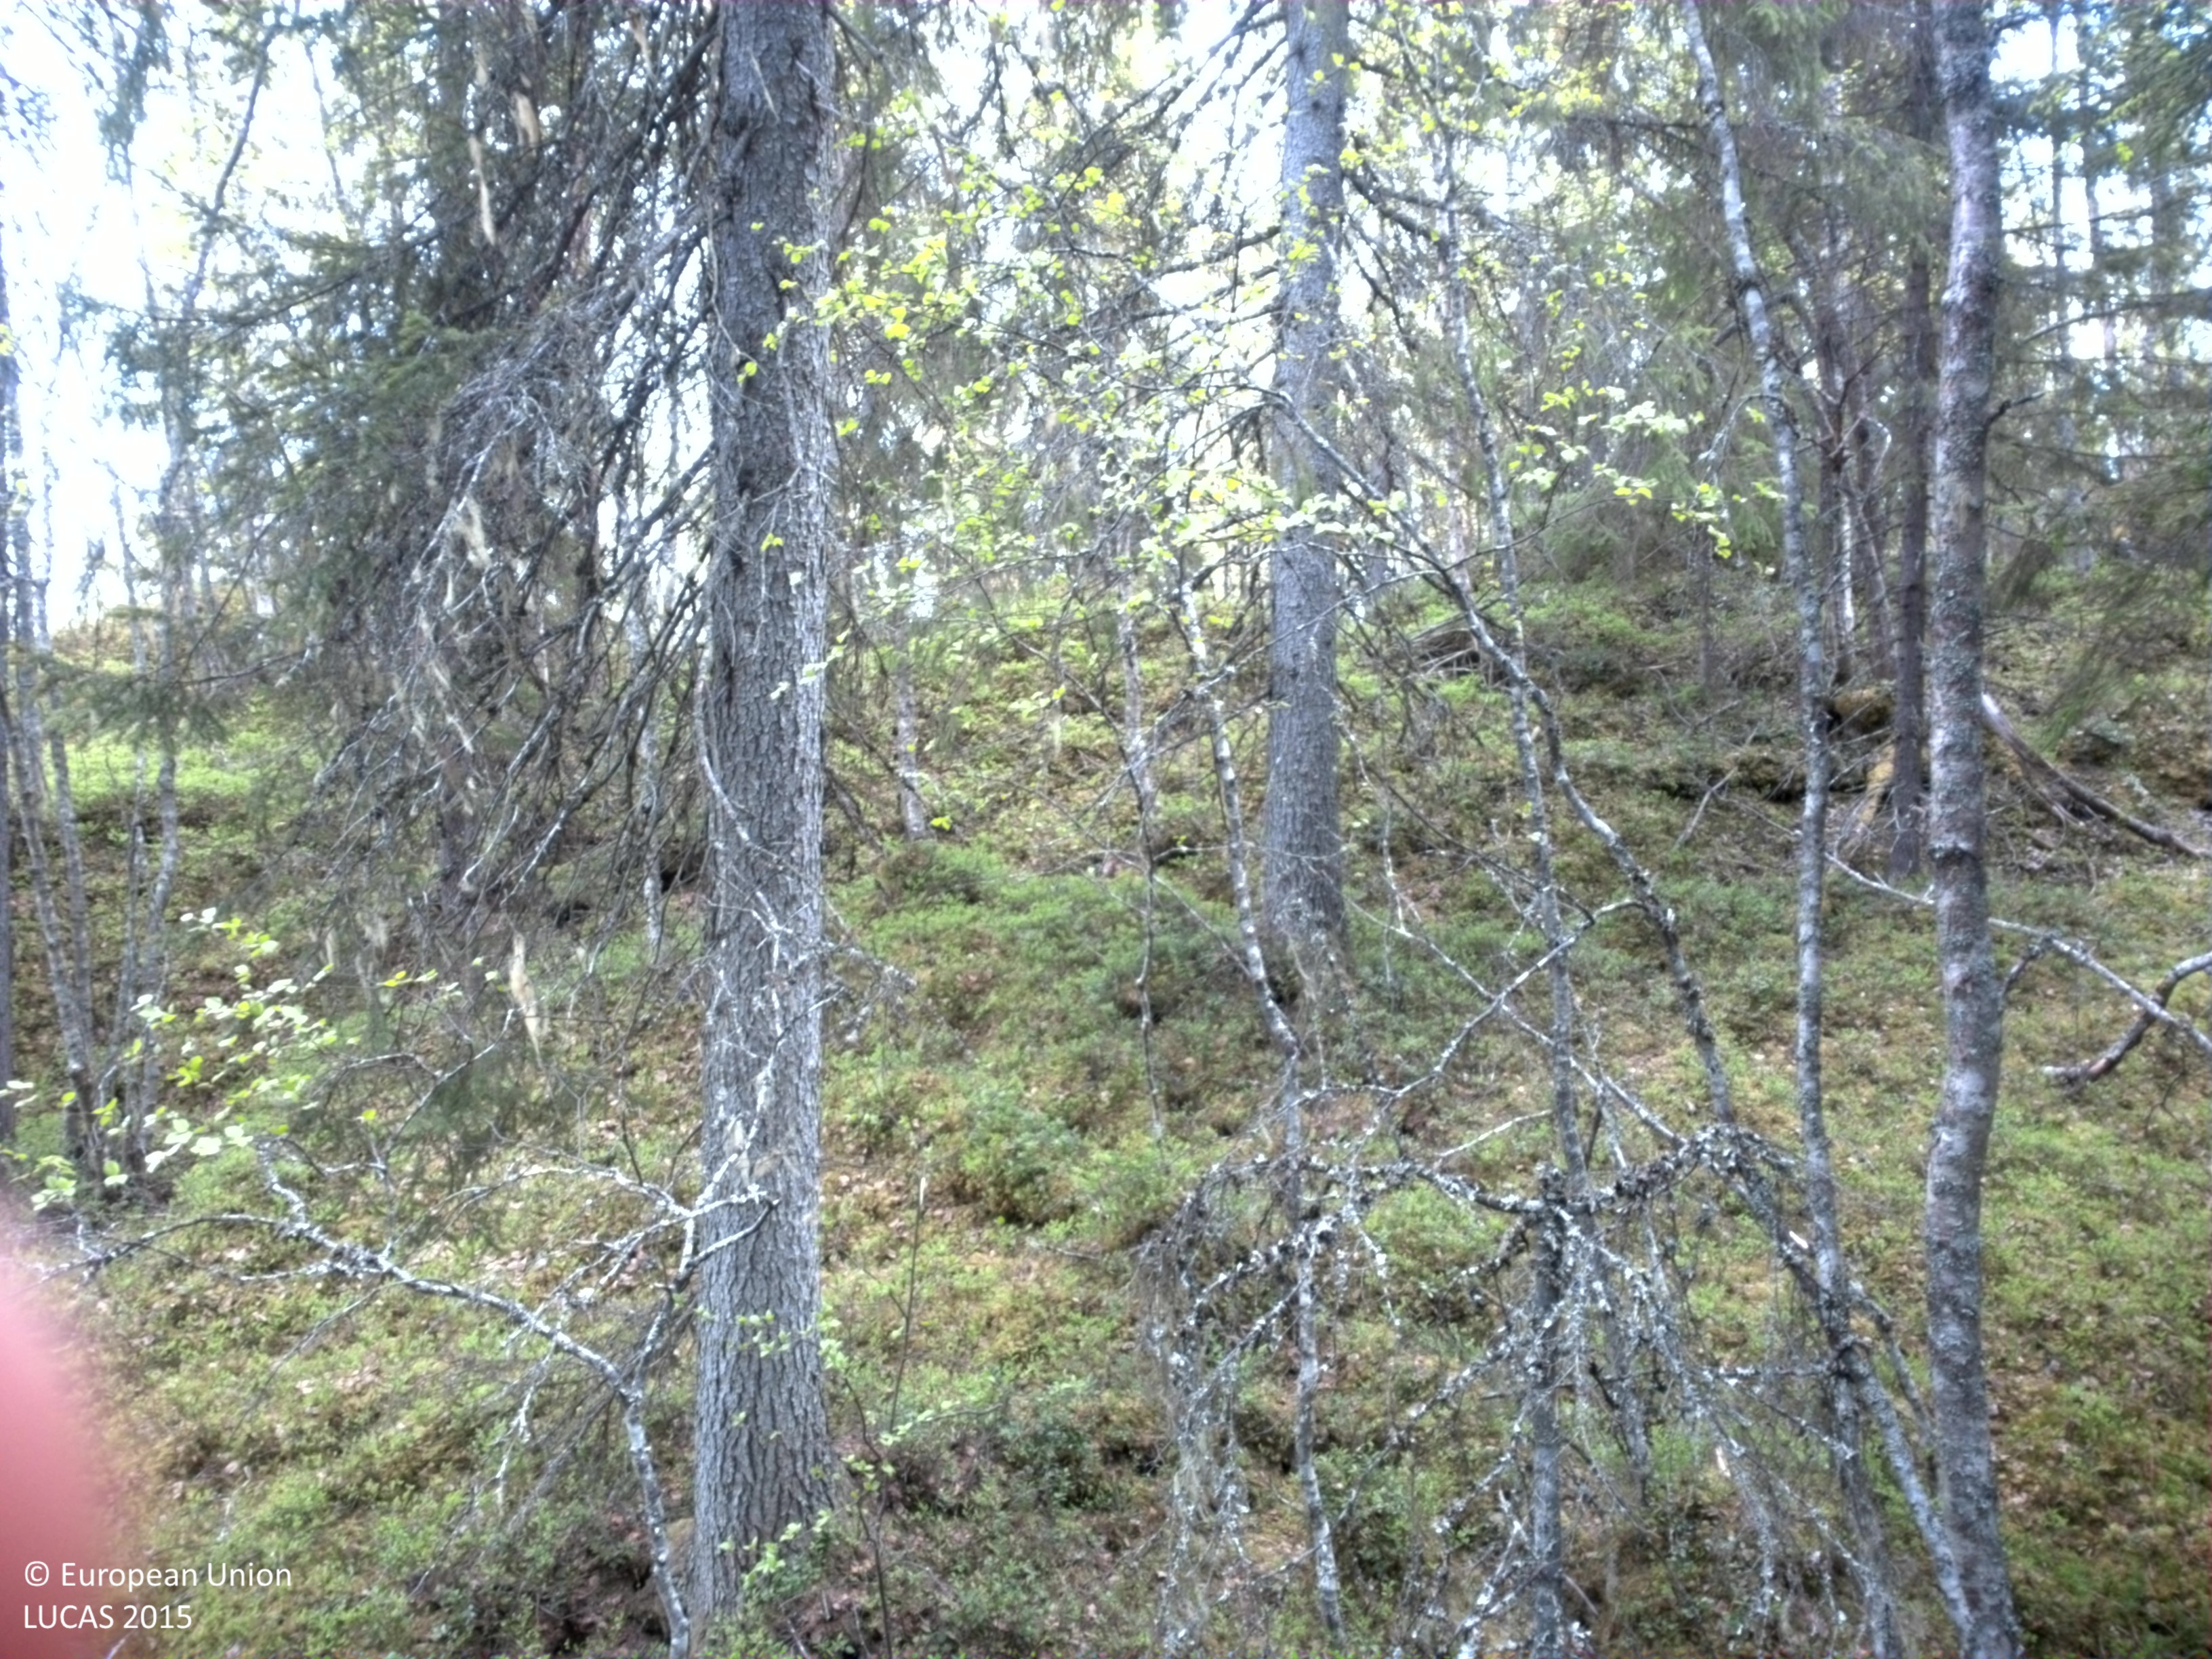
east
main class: Woodland
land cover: Spruce dominated mixed woodland
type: boreal forest
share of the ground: 50 - 75 %
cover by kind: coniferous forest trees 45 %, herbaceous plants 20 %, broadleaved forest trees 15 %, lichens and mosses 15 %, shrubs 5 %
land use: Forestry
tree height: > 5 m
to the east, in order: Spruce dominated mixed woodland; Rocks and stones; Pine dominated mixed woodland; Broadleaved woodland; Rocks and stones; Pine dominated coniferous woodland
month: June
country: SE
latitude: 64.2310
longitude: 18.0305
